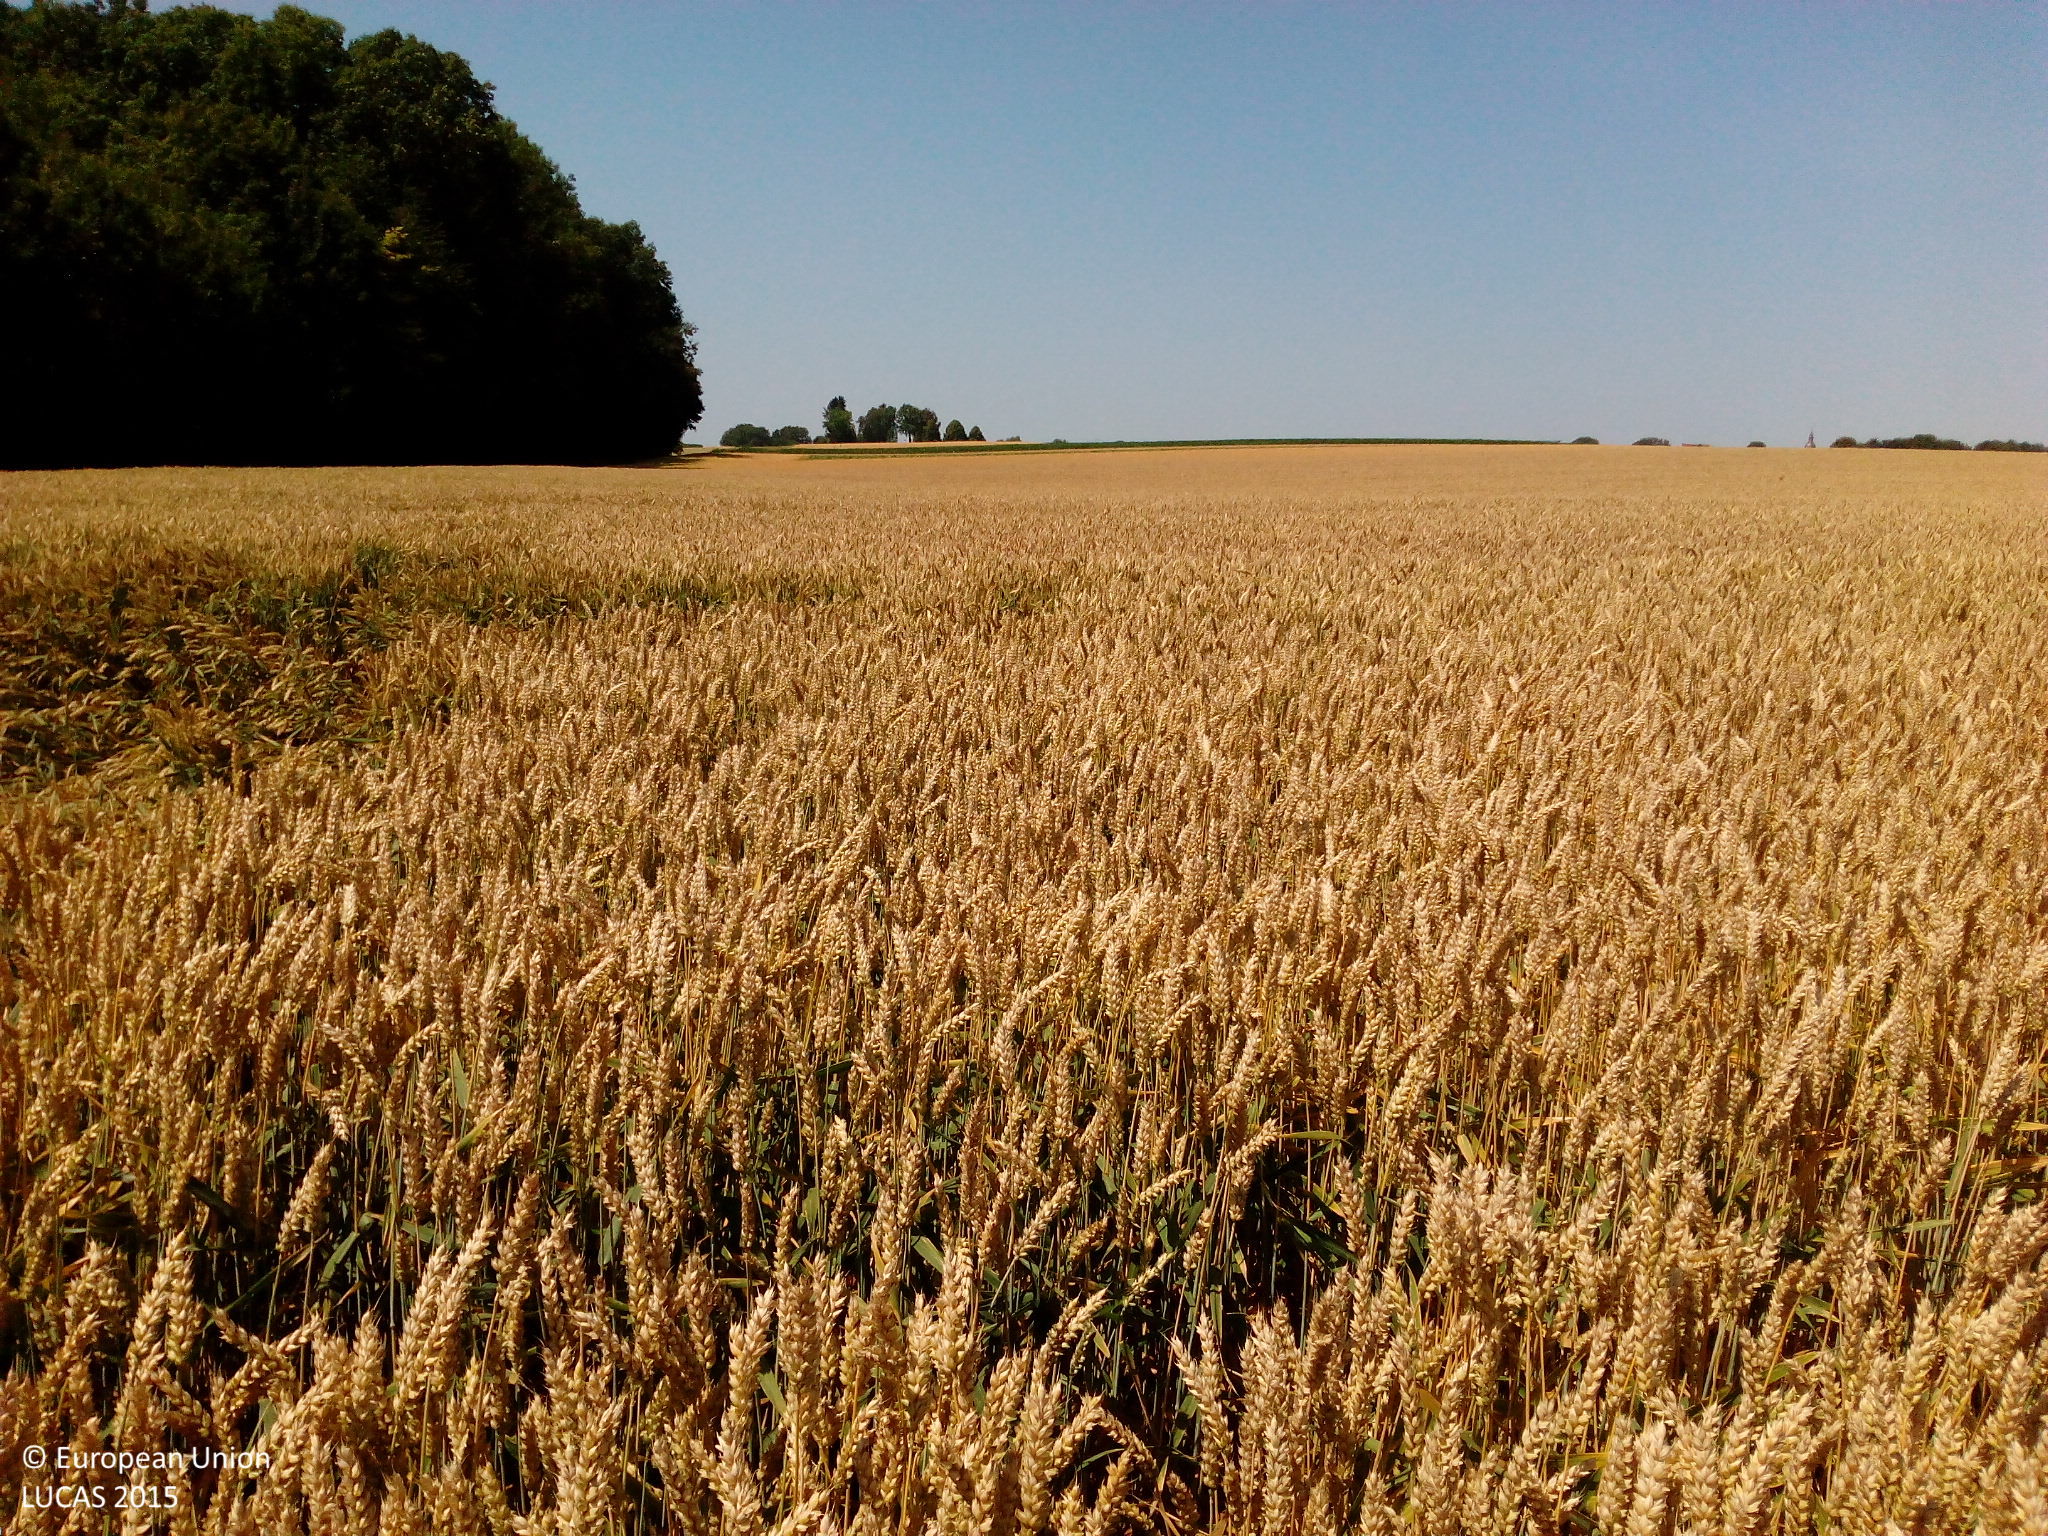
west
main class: Cropland
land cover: Common wheat
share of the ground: > 75 %
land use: Agriculture (excluding fallow land and kitchen gardens)
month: July
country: DE
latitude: 49.6267
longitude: 9.9585
